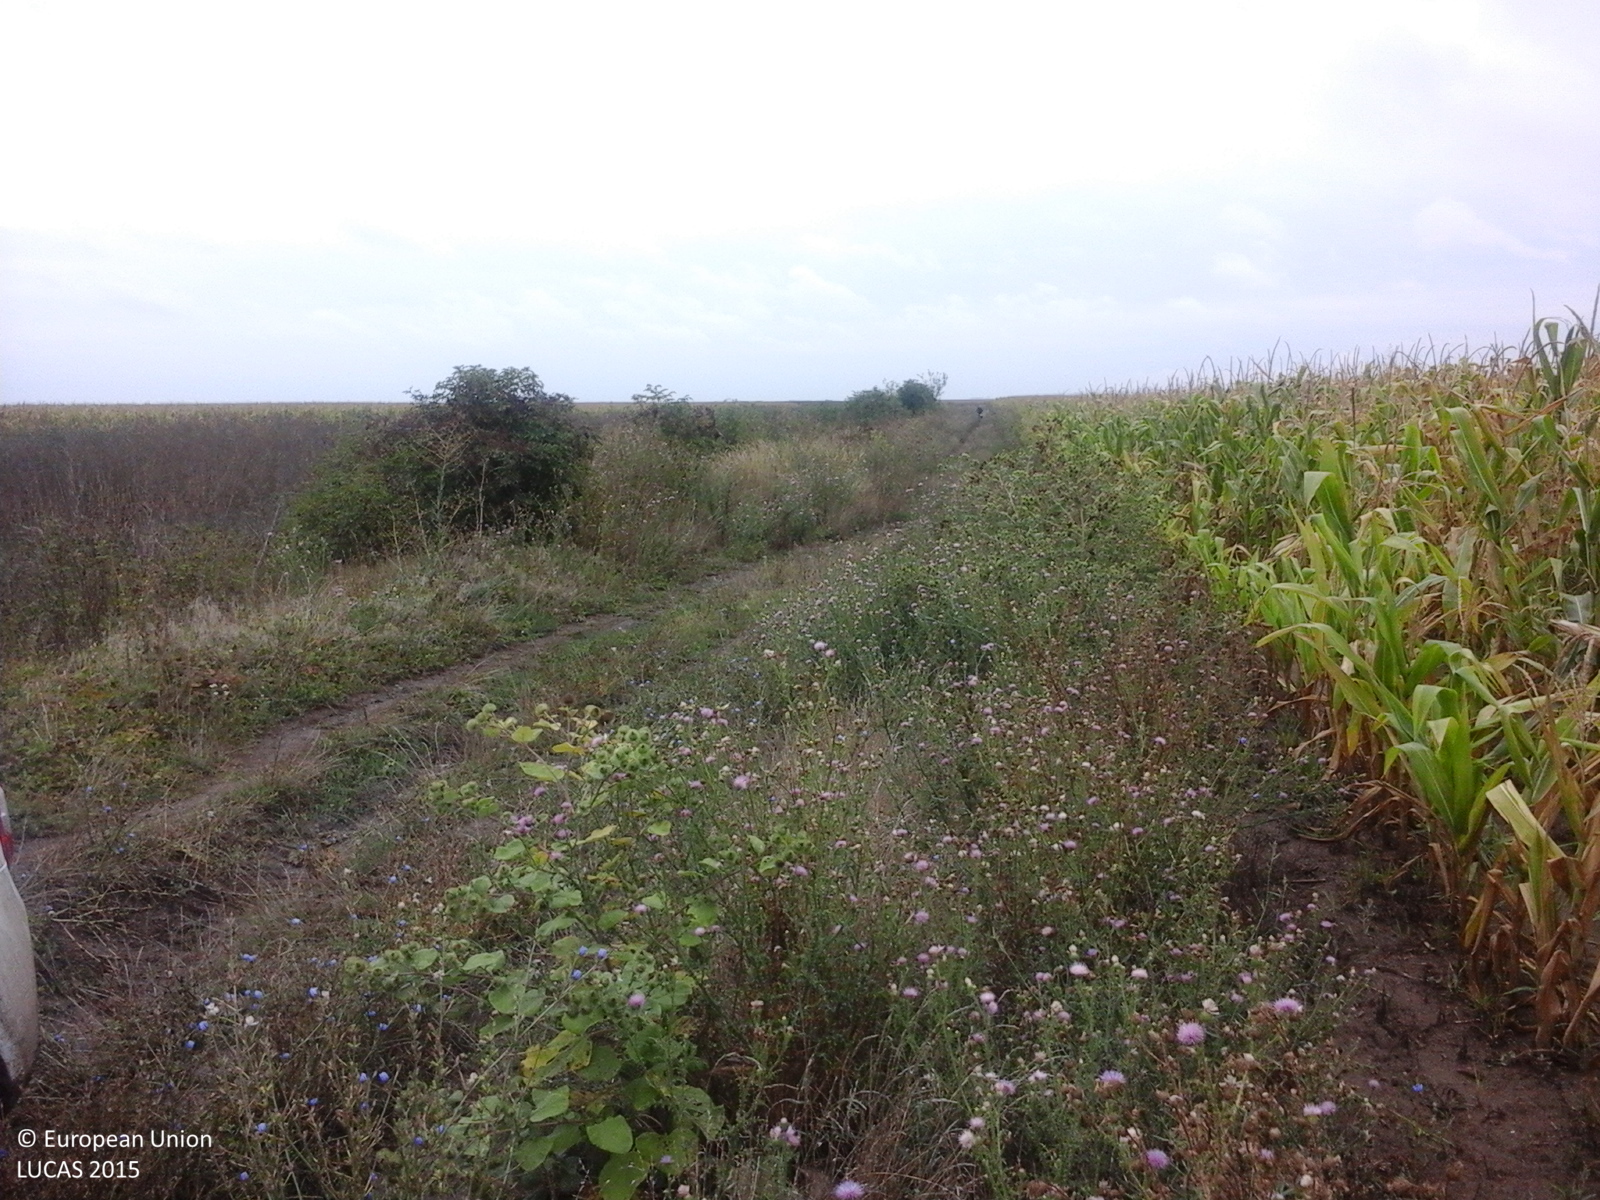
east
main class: Cropland
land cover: Maize
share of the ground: > 75 %
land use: Agriculture (excluding fallow land and kitchen gardens)
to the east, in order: Maize
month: August
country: RO
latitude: 45.8288
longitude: 20.7228
